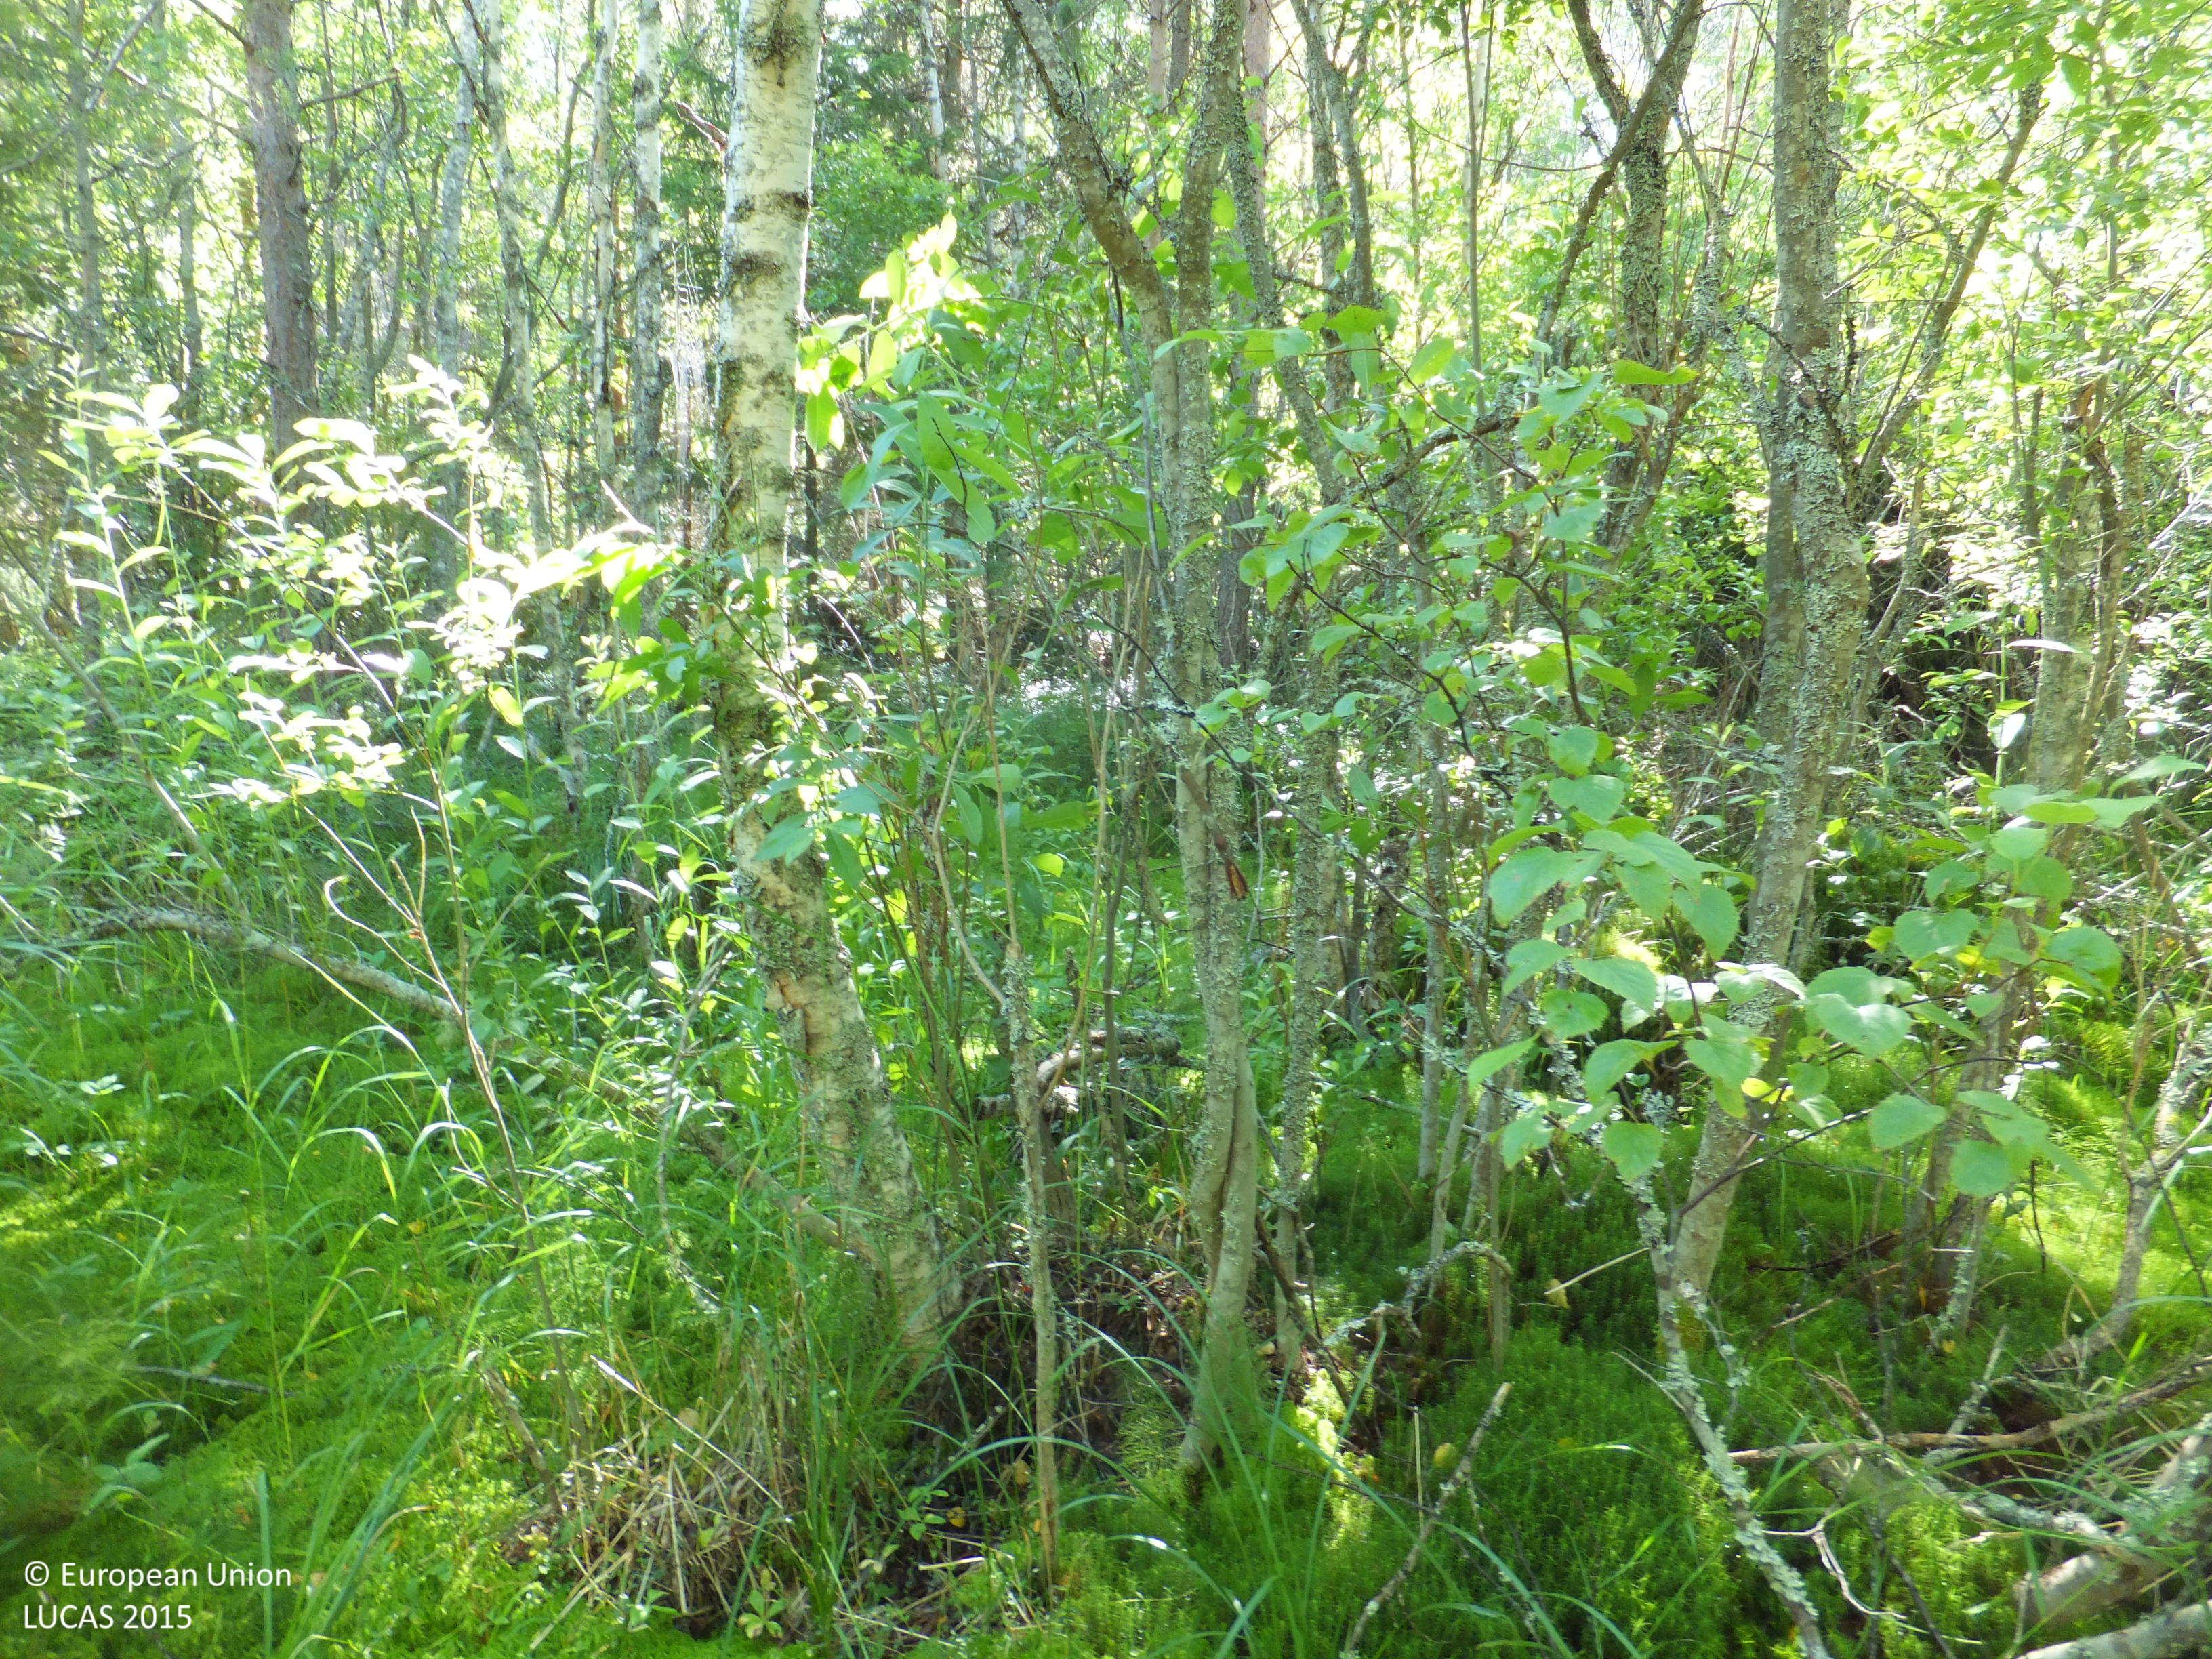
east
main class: Woodland
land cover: Broadleaved woodland
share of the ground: 50 - 75 %
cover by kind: broadleaved forest trees 60 %, lichens and mosses 20 %, herbaceous plants 10 %, coniferous forest trees 5 %, shrubs 5 %
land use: Forestry
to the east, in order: Broadleaved woodland; Other mixed woodland
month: July
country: FI
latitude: 63.1984
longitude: 21.6688
